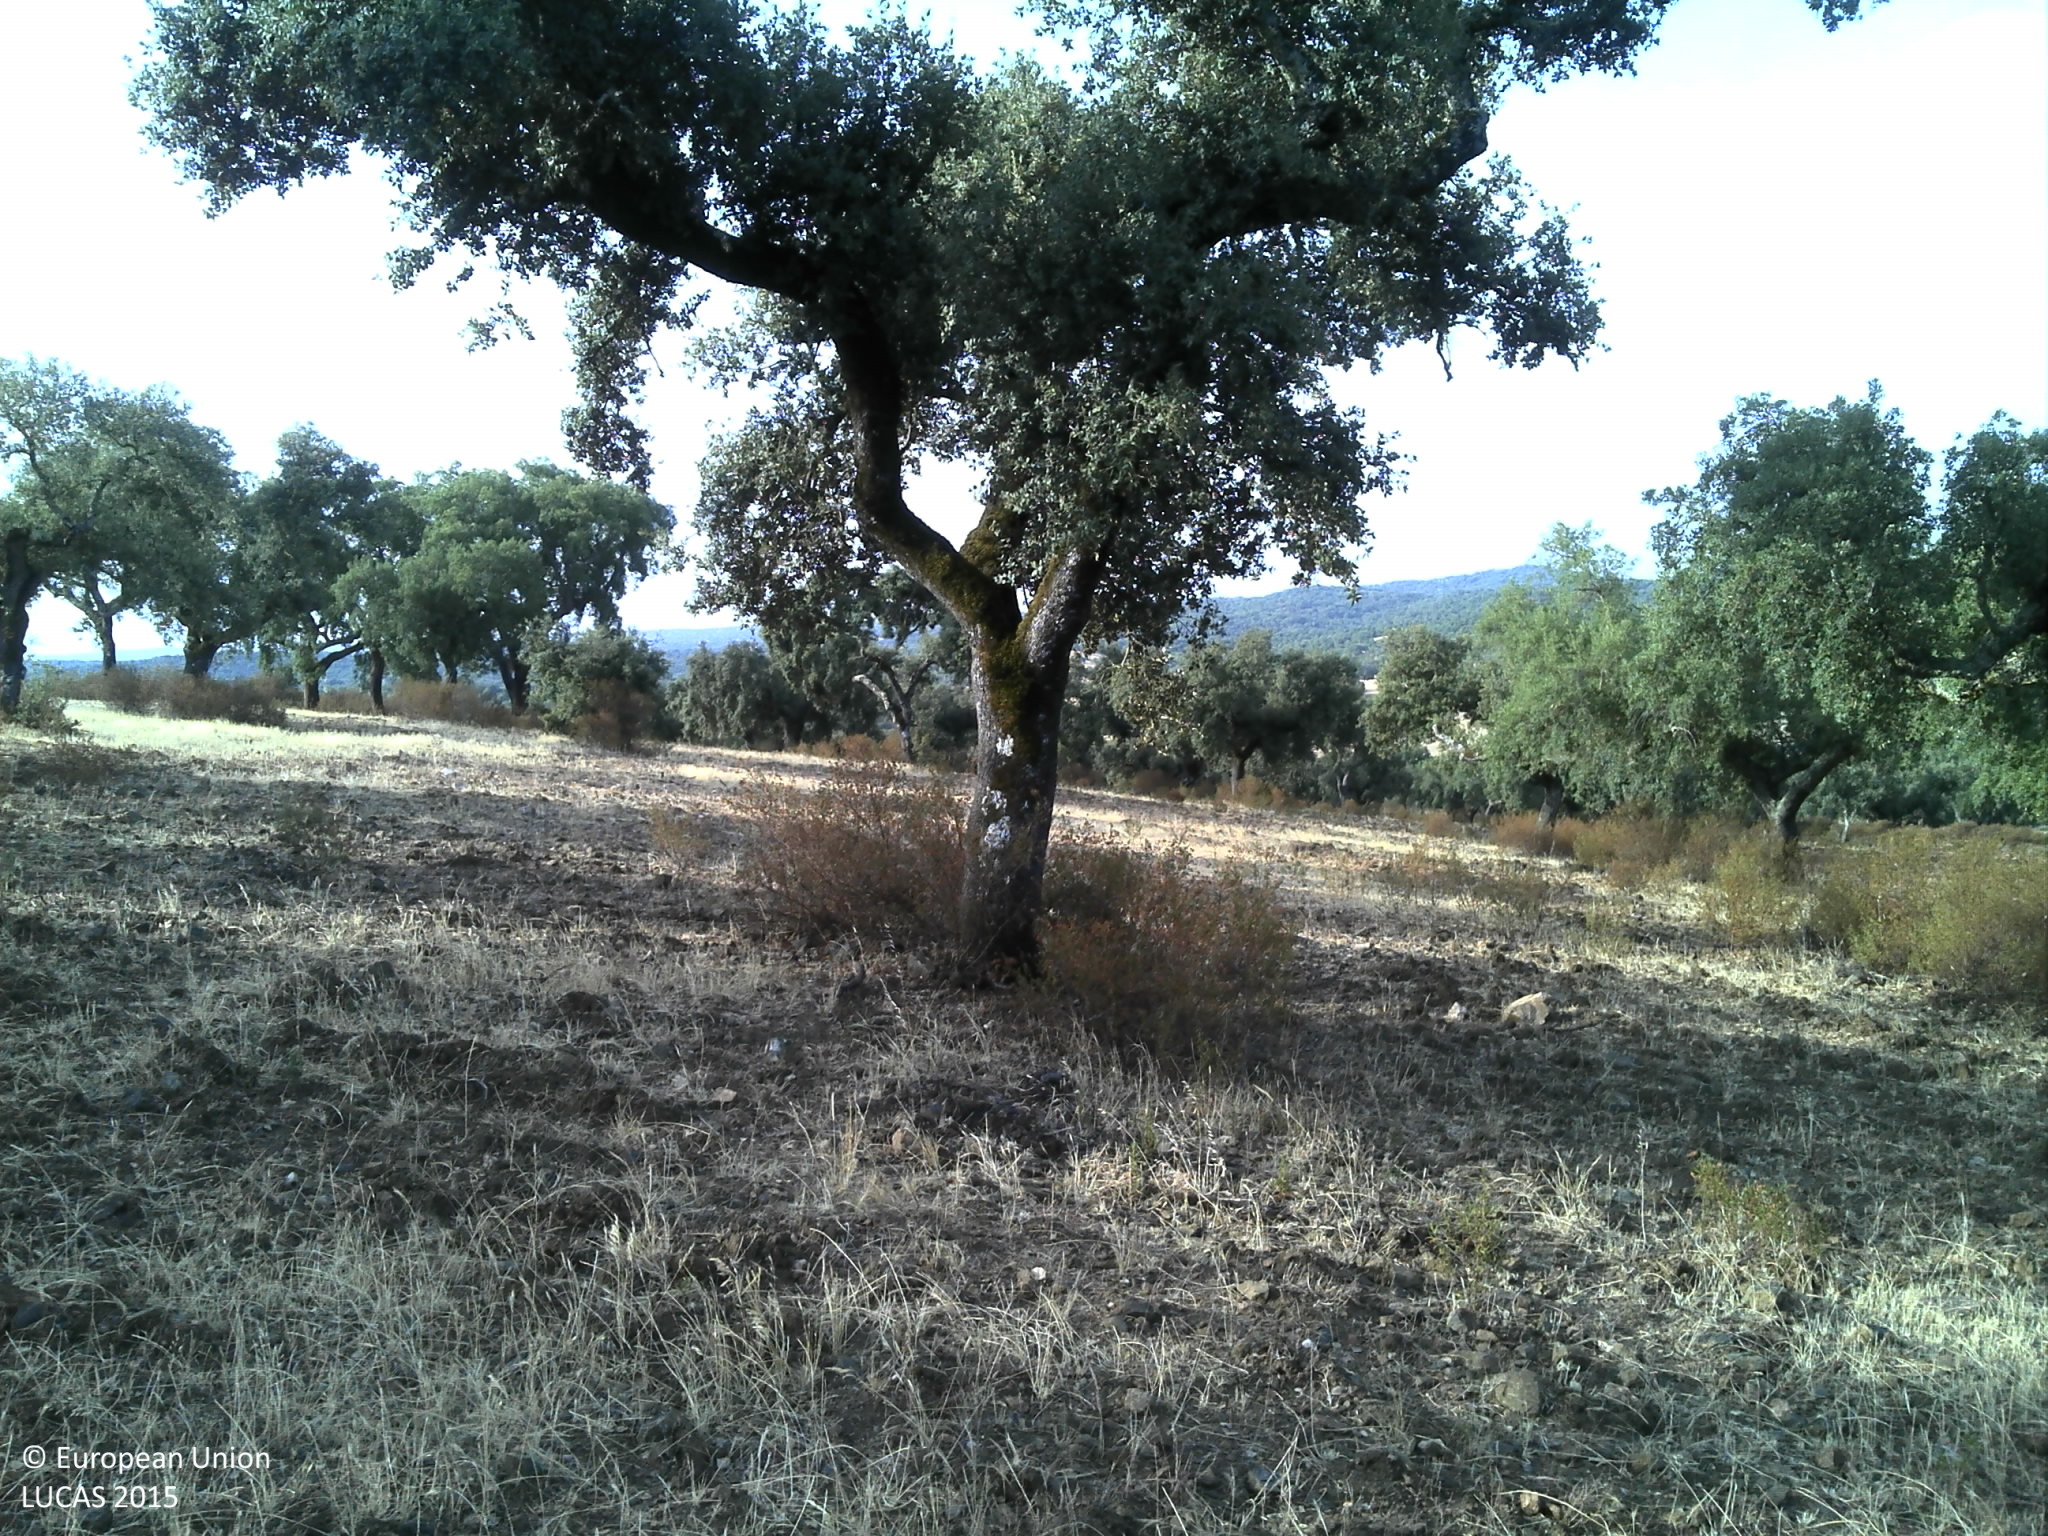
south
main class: Woodland
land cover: Broadleaved woodland
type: broadleaved evergreen forest
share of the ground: 25 - 50 %
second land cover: Grassland without tree/shrub cover
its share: < 10 %
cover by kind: unconsolidated bare surface 50 %, broadleaved forest trees 40 %, shrubs 5 %, herbaceous plants 5 %
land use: Forestry
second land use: Agriculture (excluding fallow land and kitchen gardens)
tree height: > 5 m
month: July
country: PT
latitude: 38.7457
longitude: -7.7460
